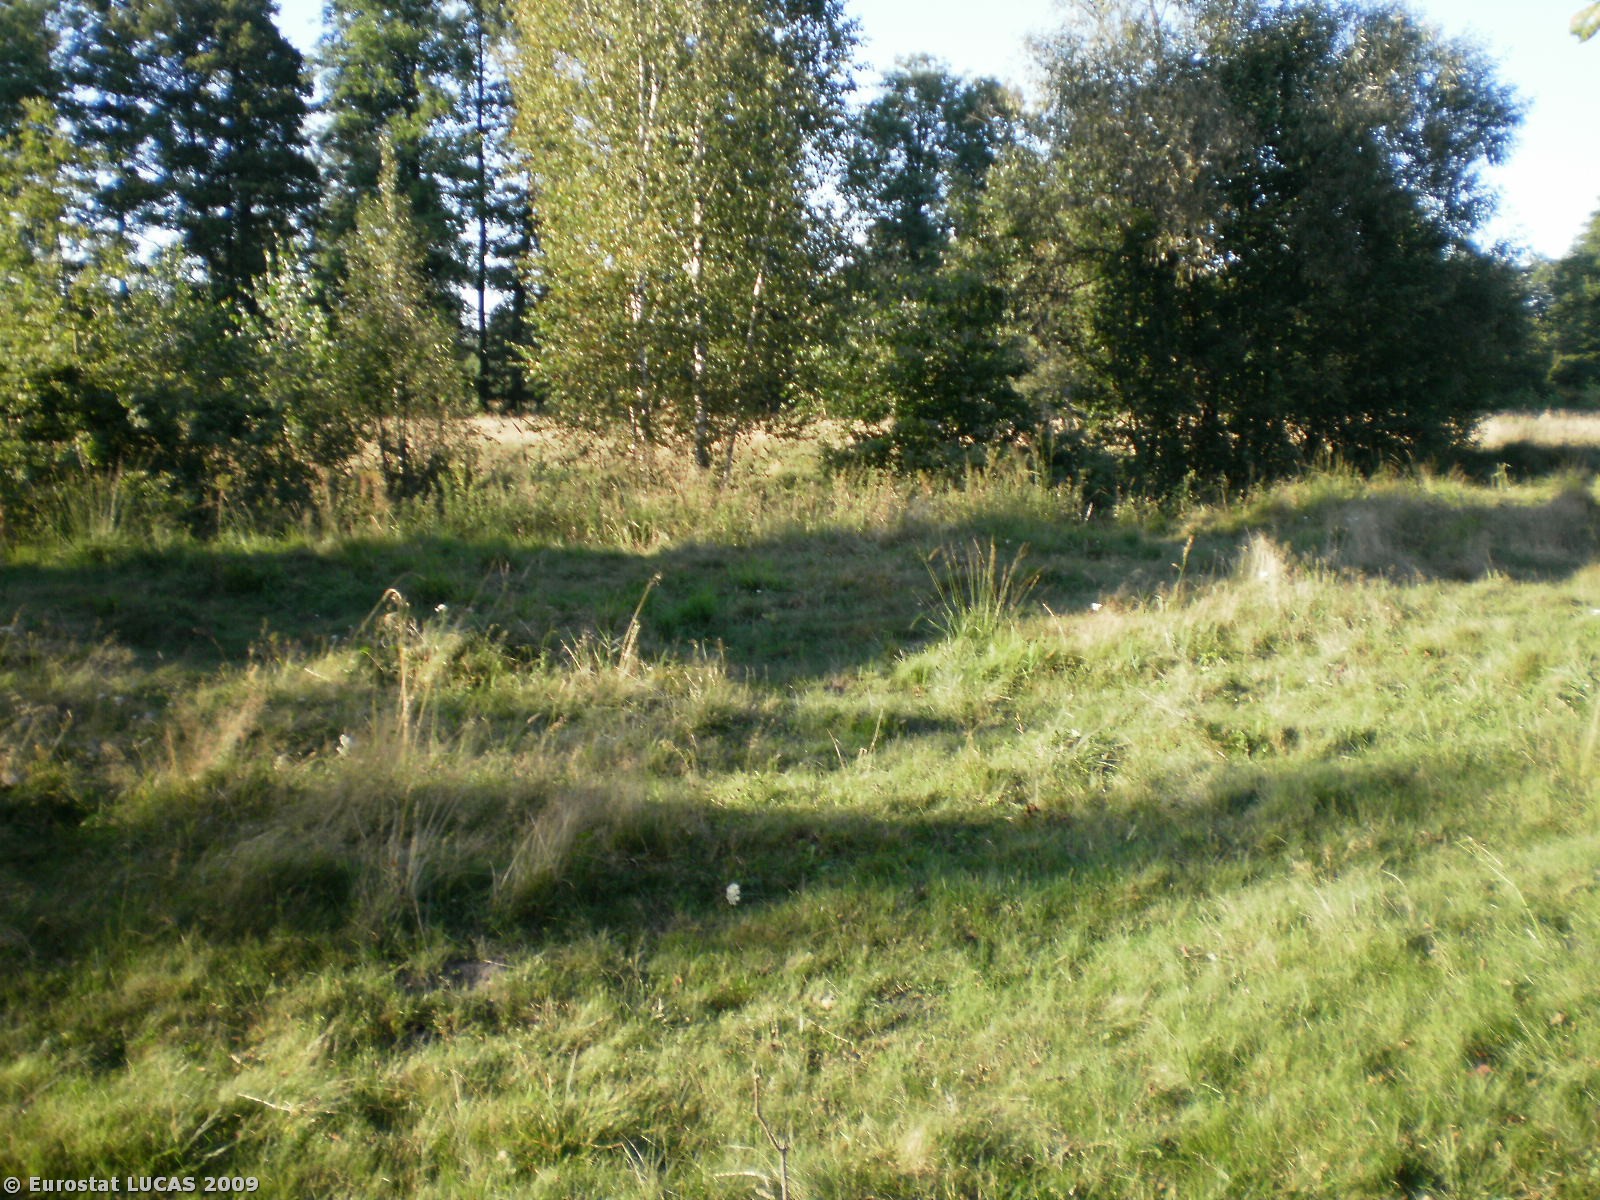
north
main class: Grassland
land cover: Grassland with sparse tree/shrub cover
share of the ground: > 75 %
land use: Agriculture (excluding fallow land and kitchen gardens)
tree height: < 5 m
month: August
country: PL
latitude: 53.2509
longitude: 21.8812
